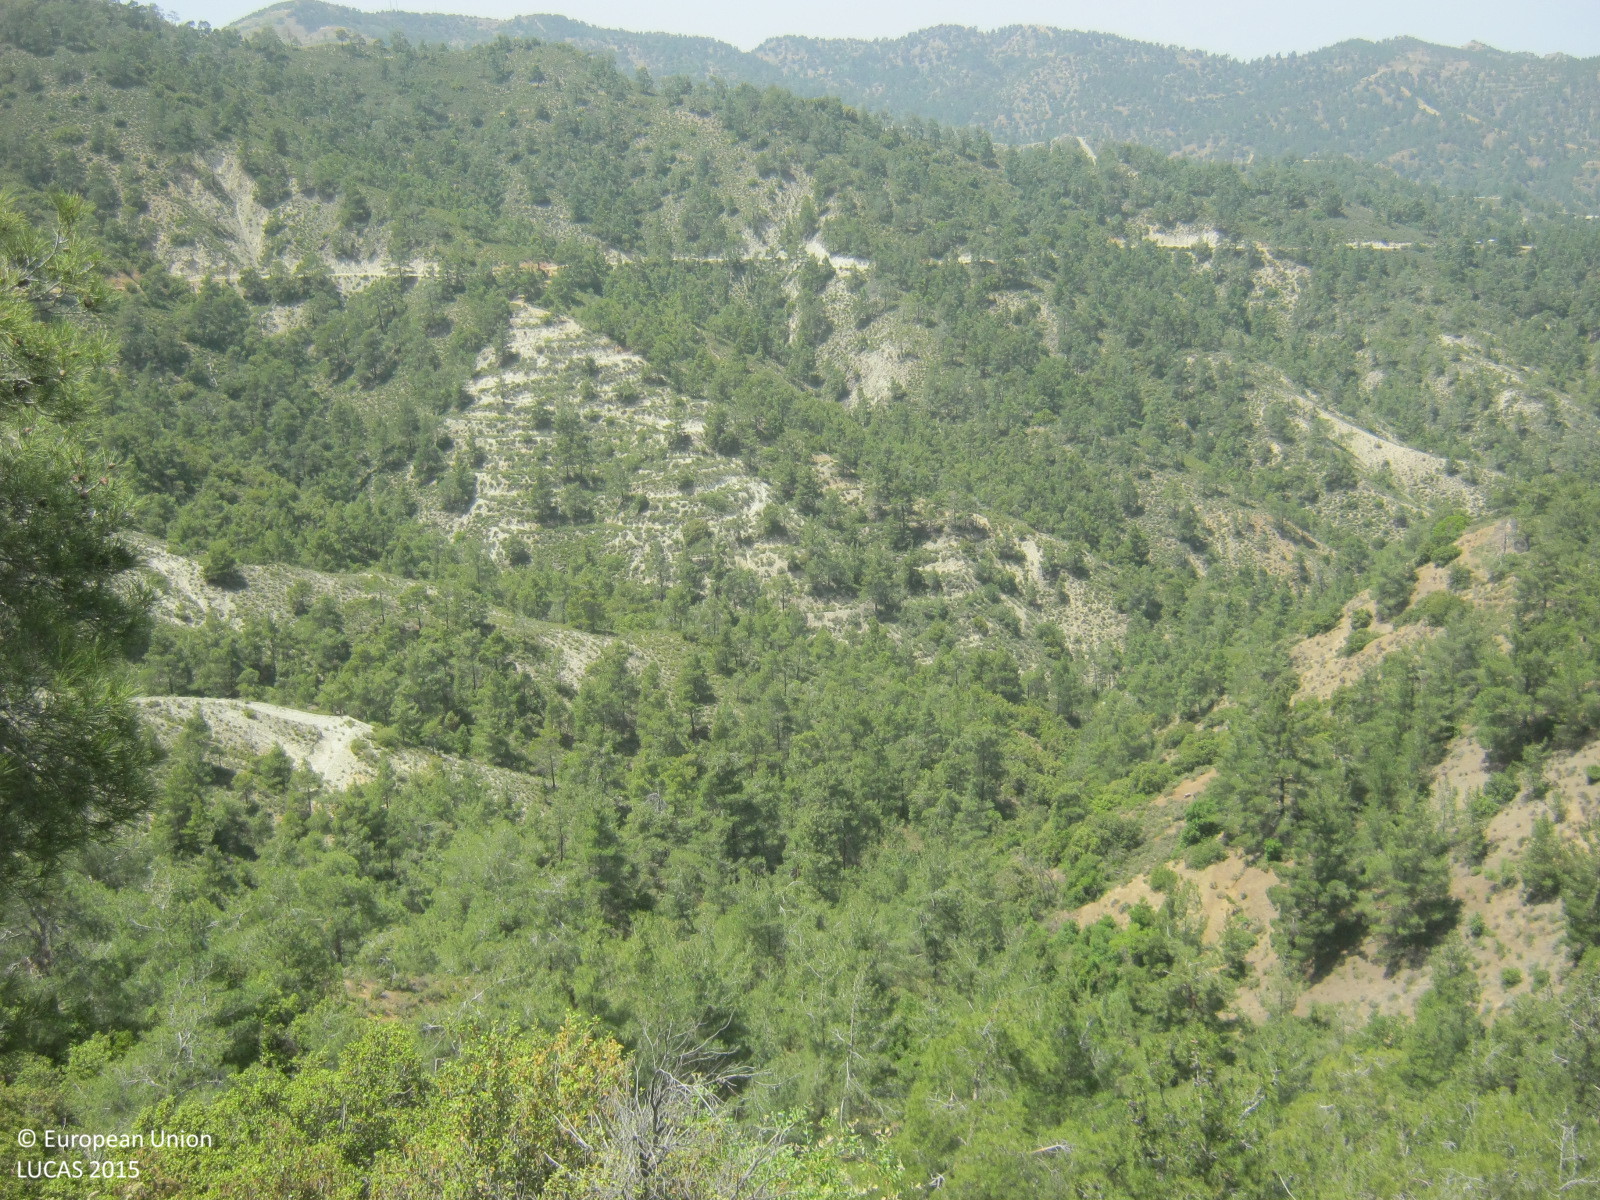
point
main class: Woodland
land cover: Pine dominated coniferous woodland
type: coniferous forest of the mediterranean region
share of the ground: > 75 %
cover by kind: coniferous forest trees 75 %, shrubs 15 %, unconsolidated bare surface 10 %
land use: Forestry
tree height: > 5 m
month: May
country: CY
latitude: 34.9932
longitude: 32.8805
